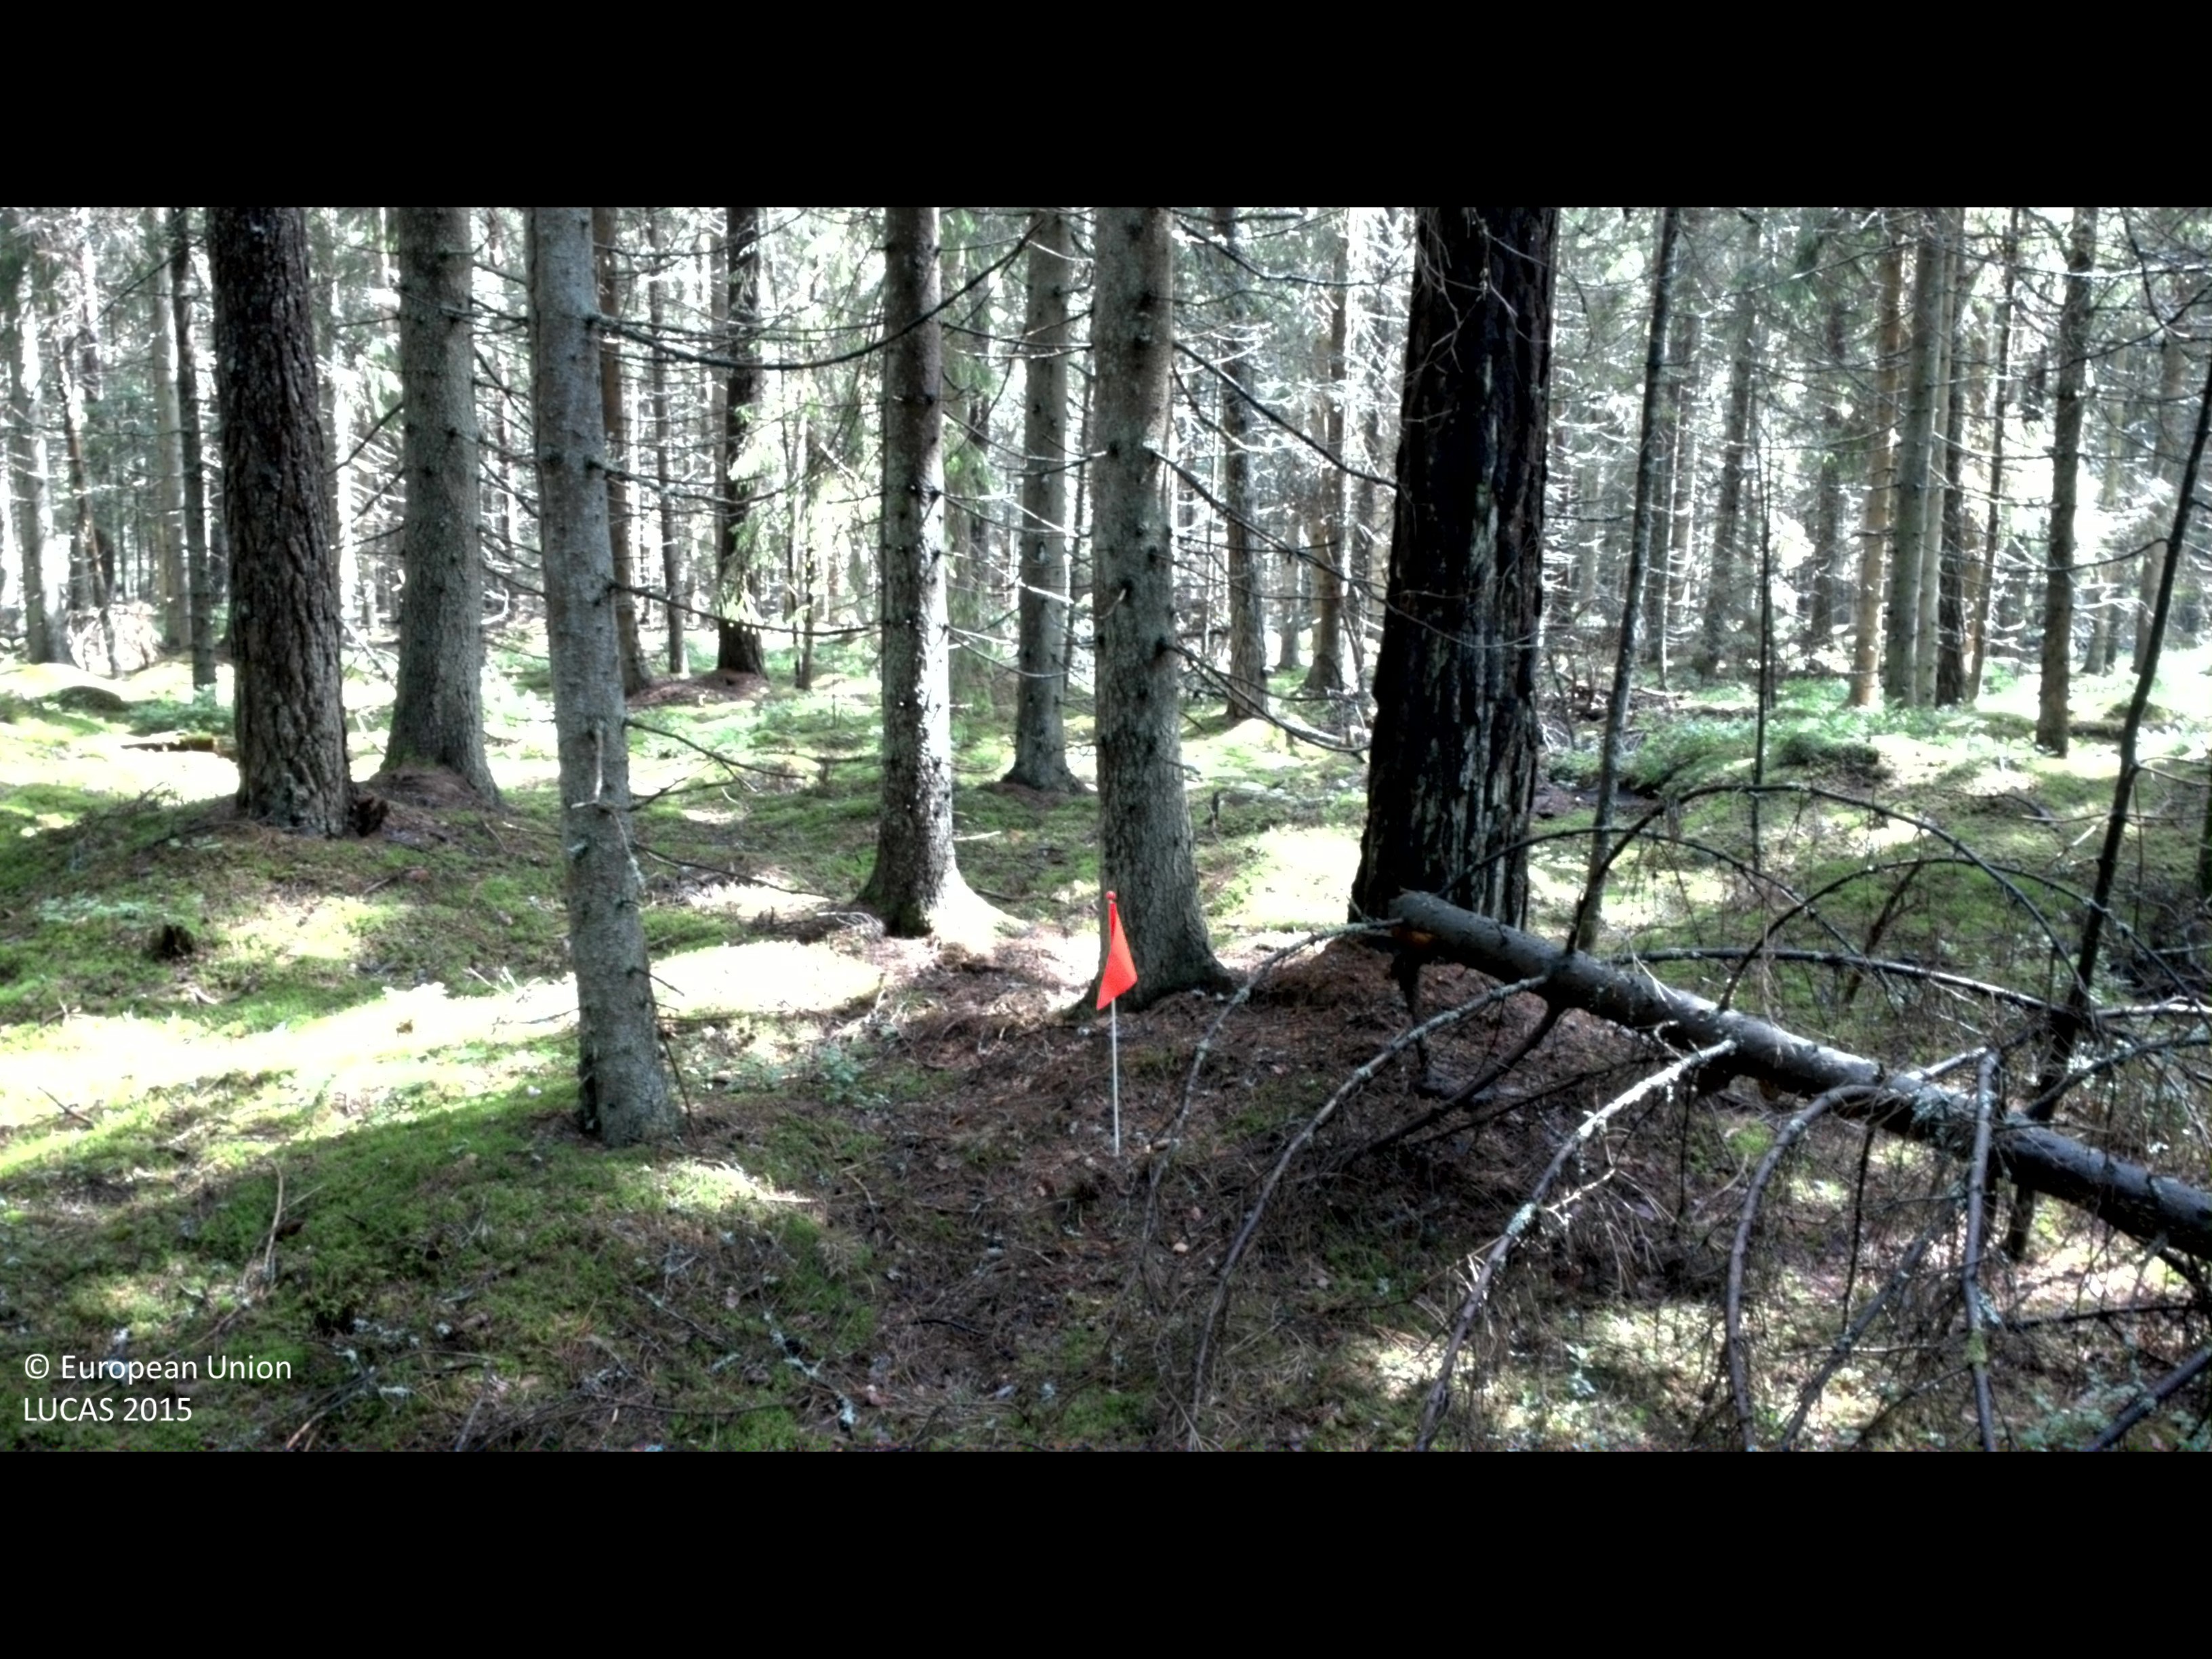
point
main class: Woodland
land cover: Spruce dominated coniferous woodland
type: boreal forest
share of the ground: > 75 %
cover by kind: coniferous forest trees 80 %, shrubs 10 %, lichens and mosses 10 %
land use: Forestry
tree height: > 5 m
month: June
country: SE
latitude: 58.0623
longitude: 16.1150
